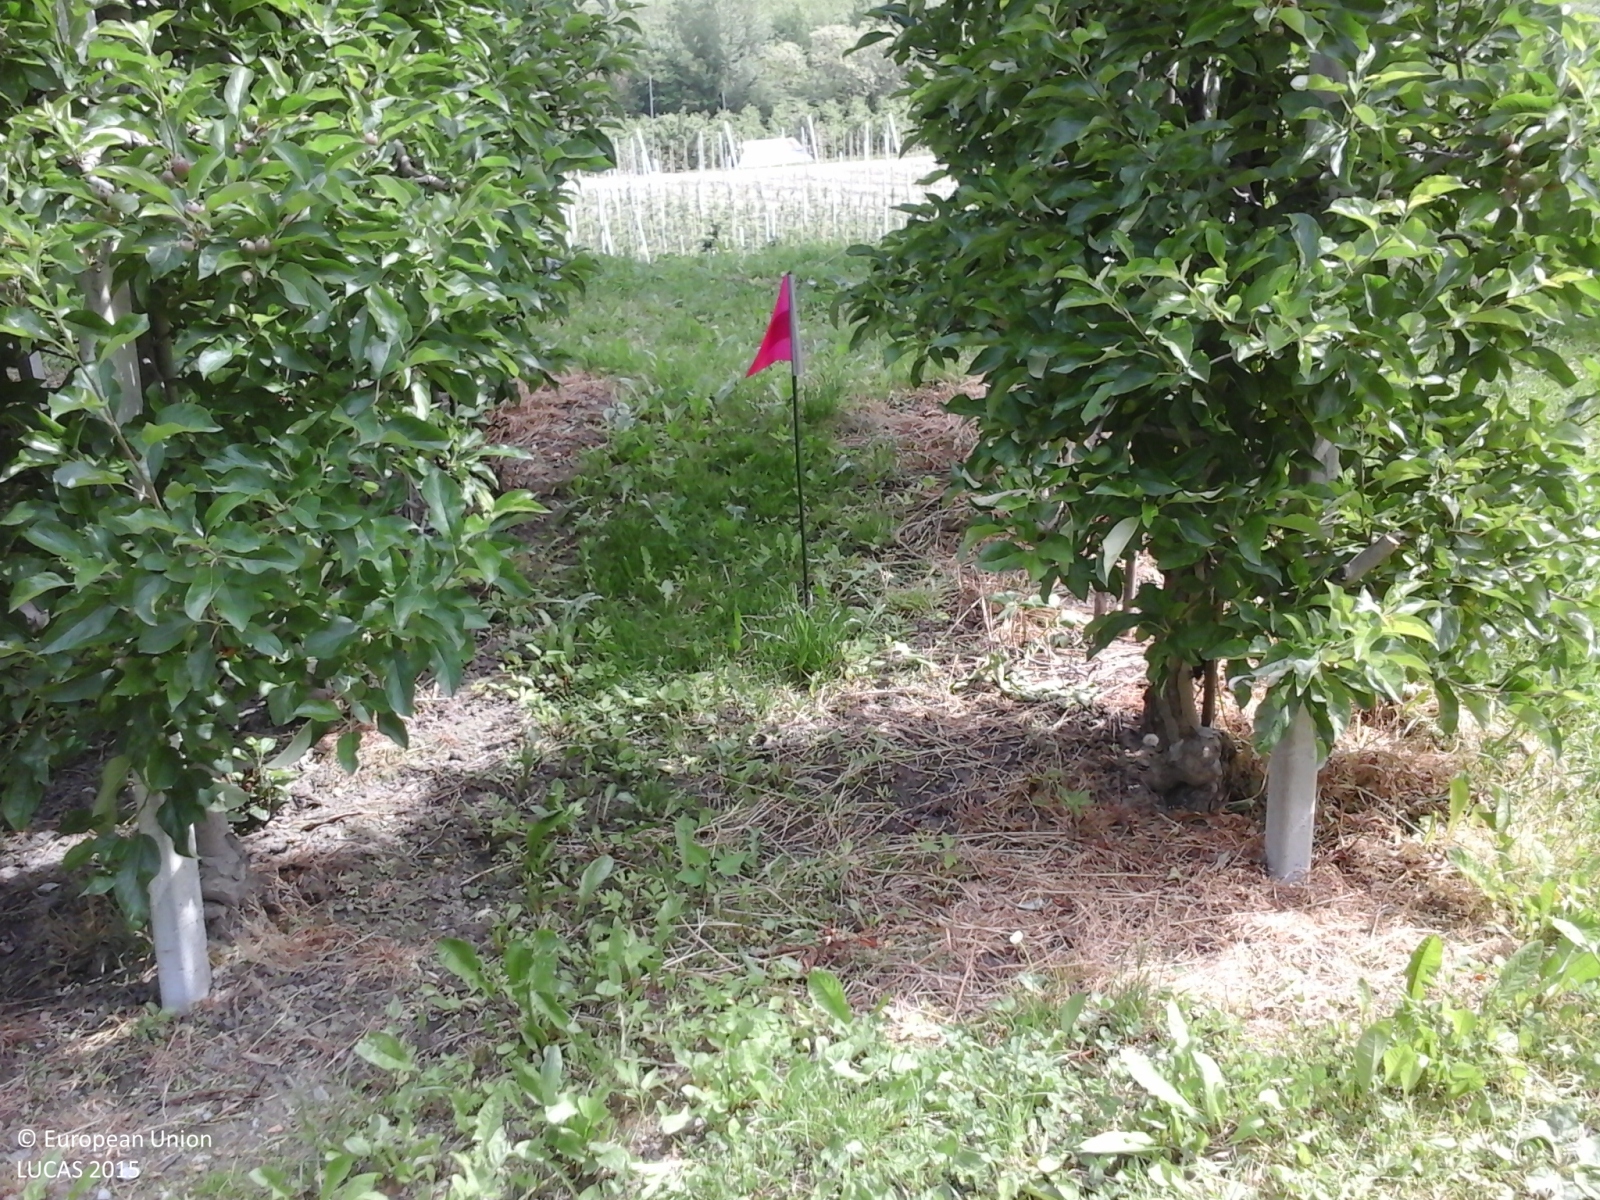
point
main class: Cropland
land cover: Apple fruit
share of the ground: > 75 %
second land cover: Grassland without tree/shrub cover
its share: > 75 %
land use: Agriculture (excluding fallow land and kitchen gardens)
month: May
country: IT
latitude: 46.6186
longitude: 10.7695
